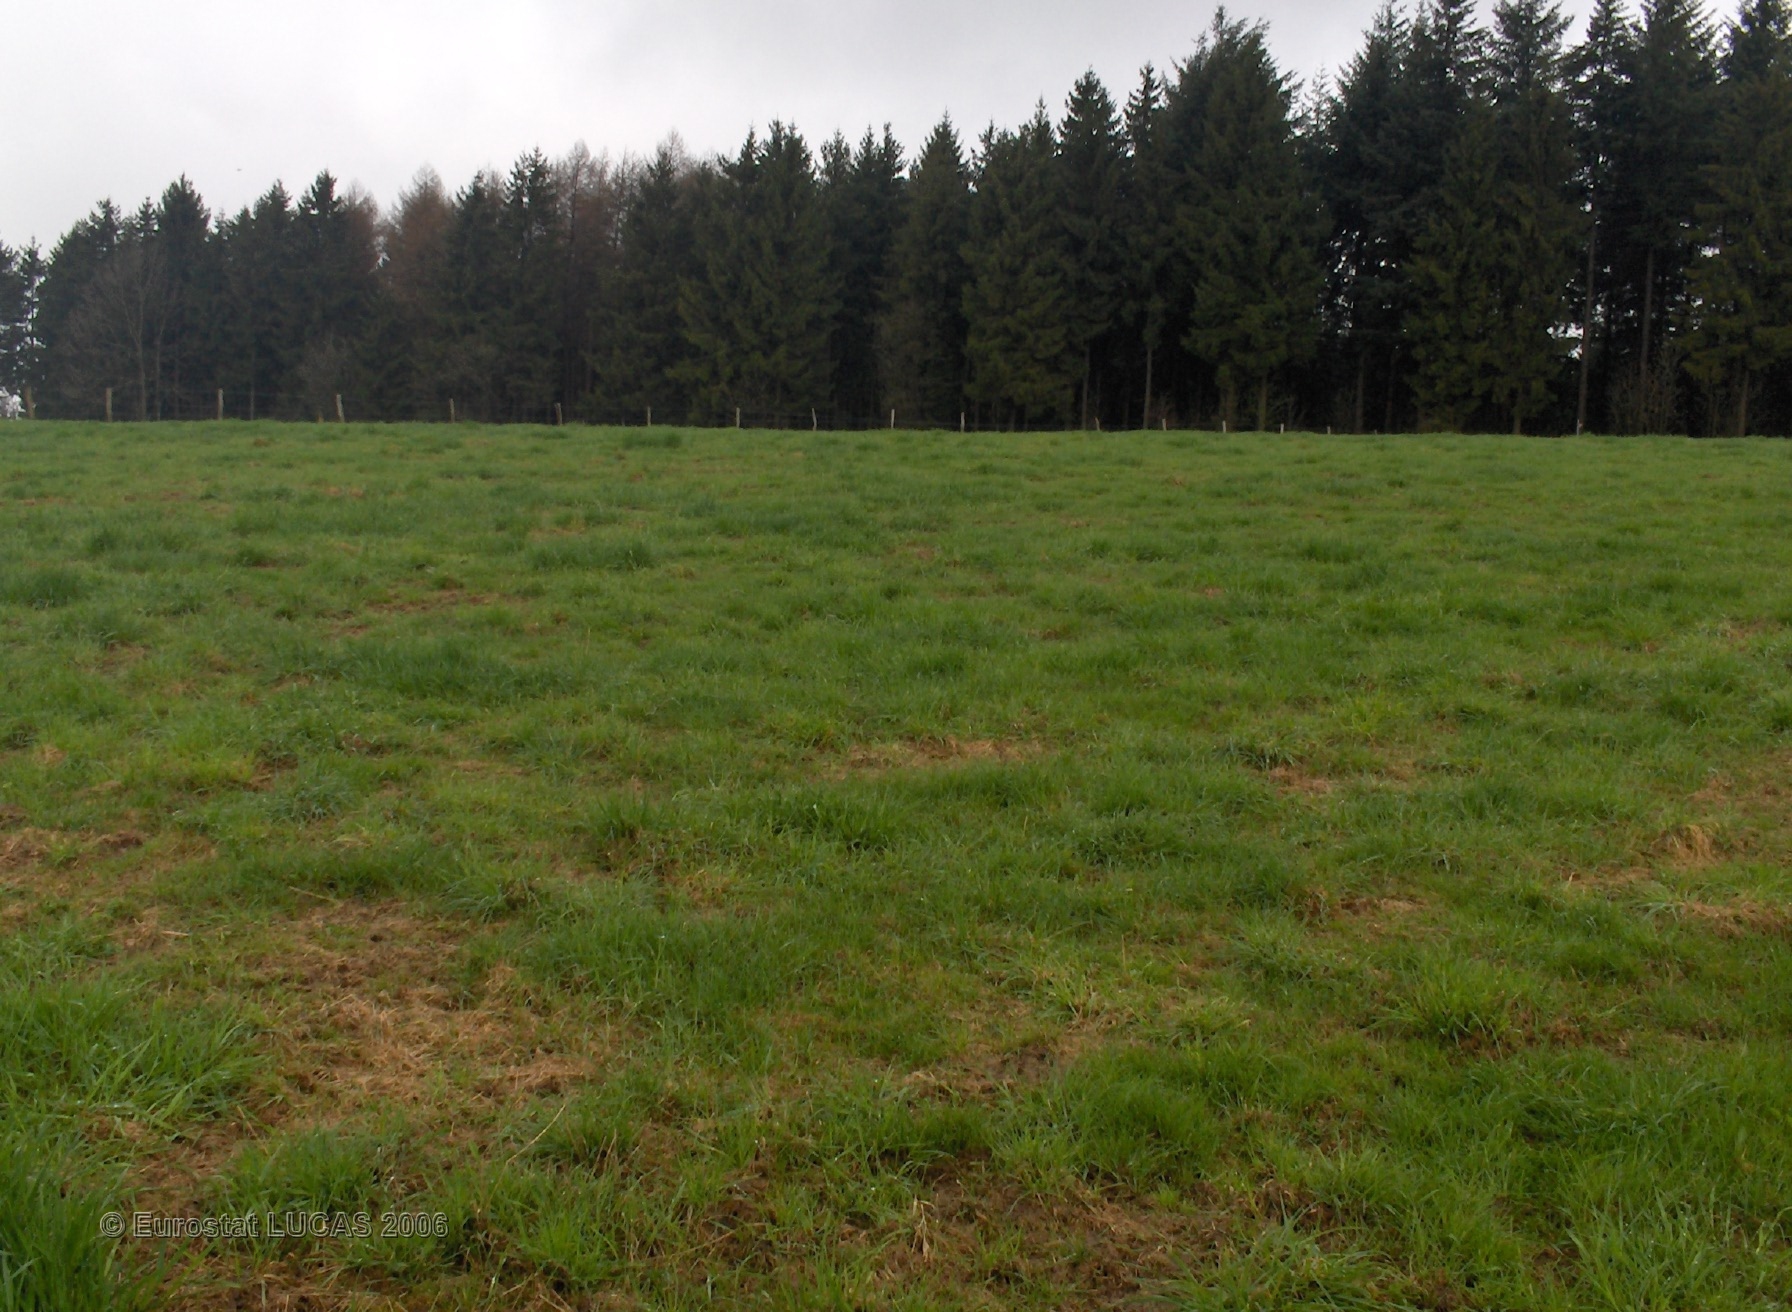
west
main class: Grassland
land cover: Grassland without tree/shrub cover
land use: Agriculture (excluding fallow land and kitchen gardens)
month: May
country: BE
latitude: 50.3592
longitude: 6.3307
